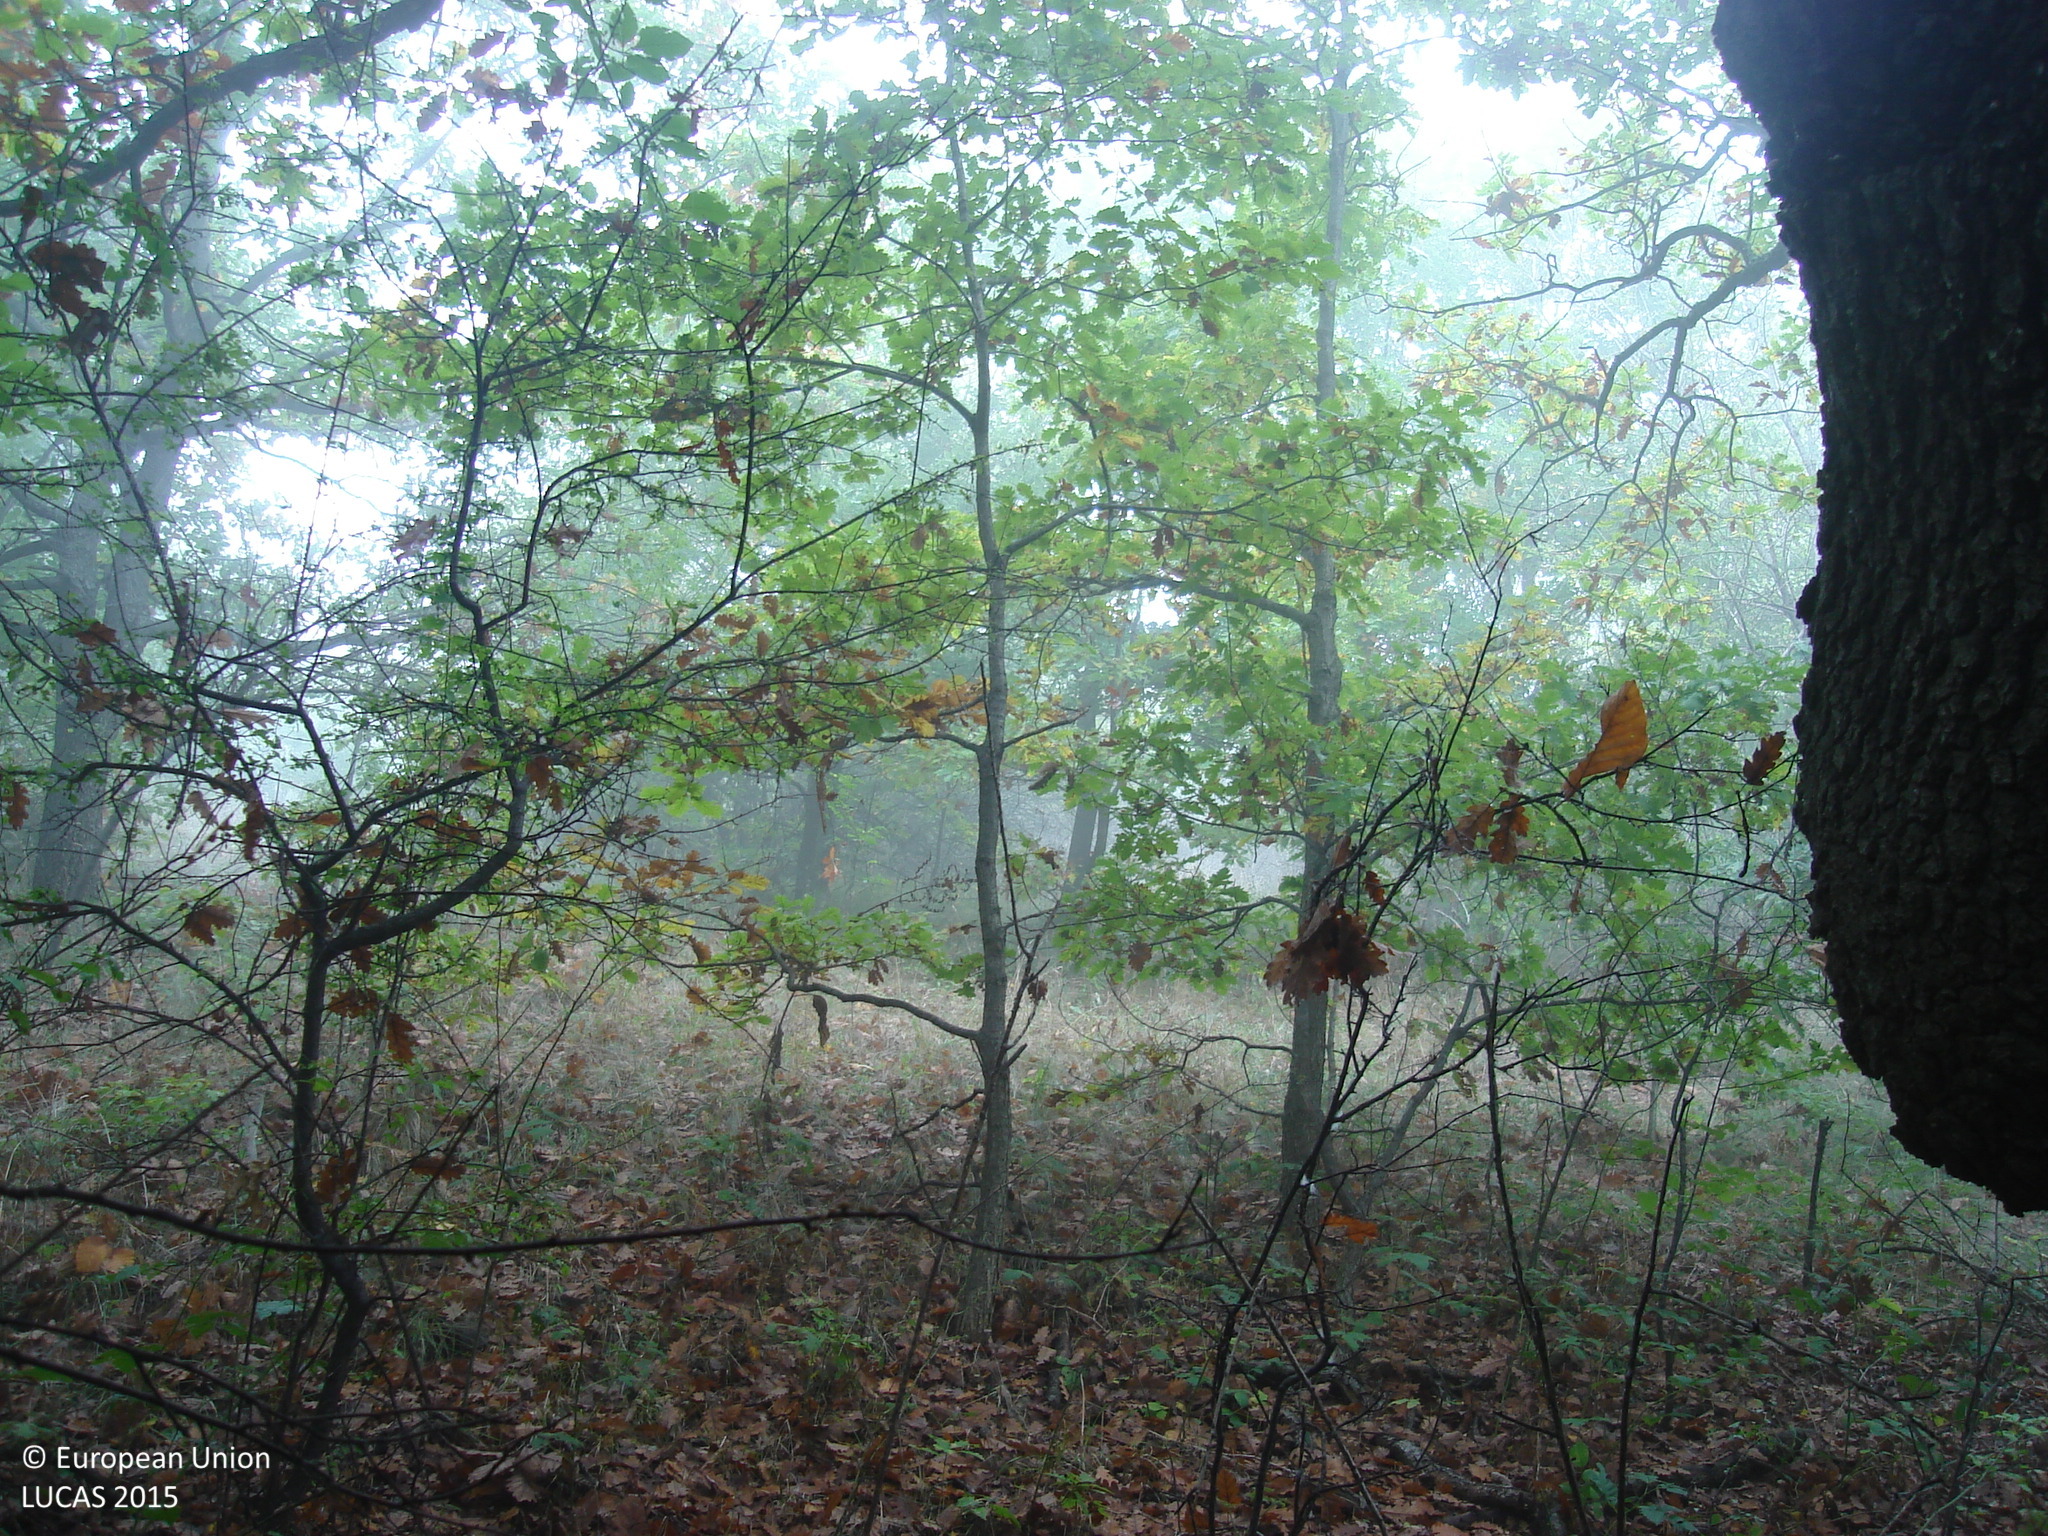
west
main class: Woodland
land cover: Broadleaved woodland
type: mesophytic deciduous forest
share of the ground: > 75 %
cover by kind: broadleaved forest trees 80 %, unconsolidated bare surface 20 %
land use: Forestry
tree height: > 5 m
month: October
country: BG
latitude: 42.4777
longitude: 23.8957
